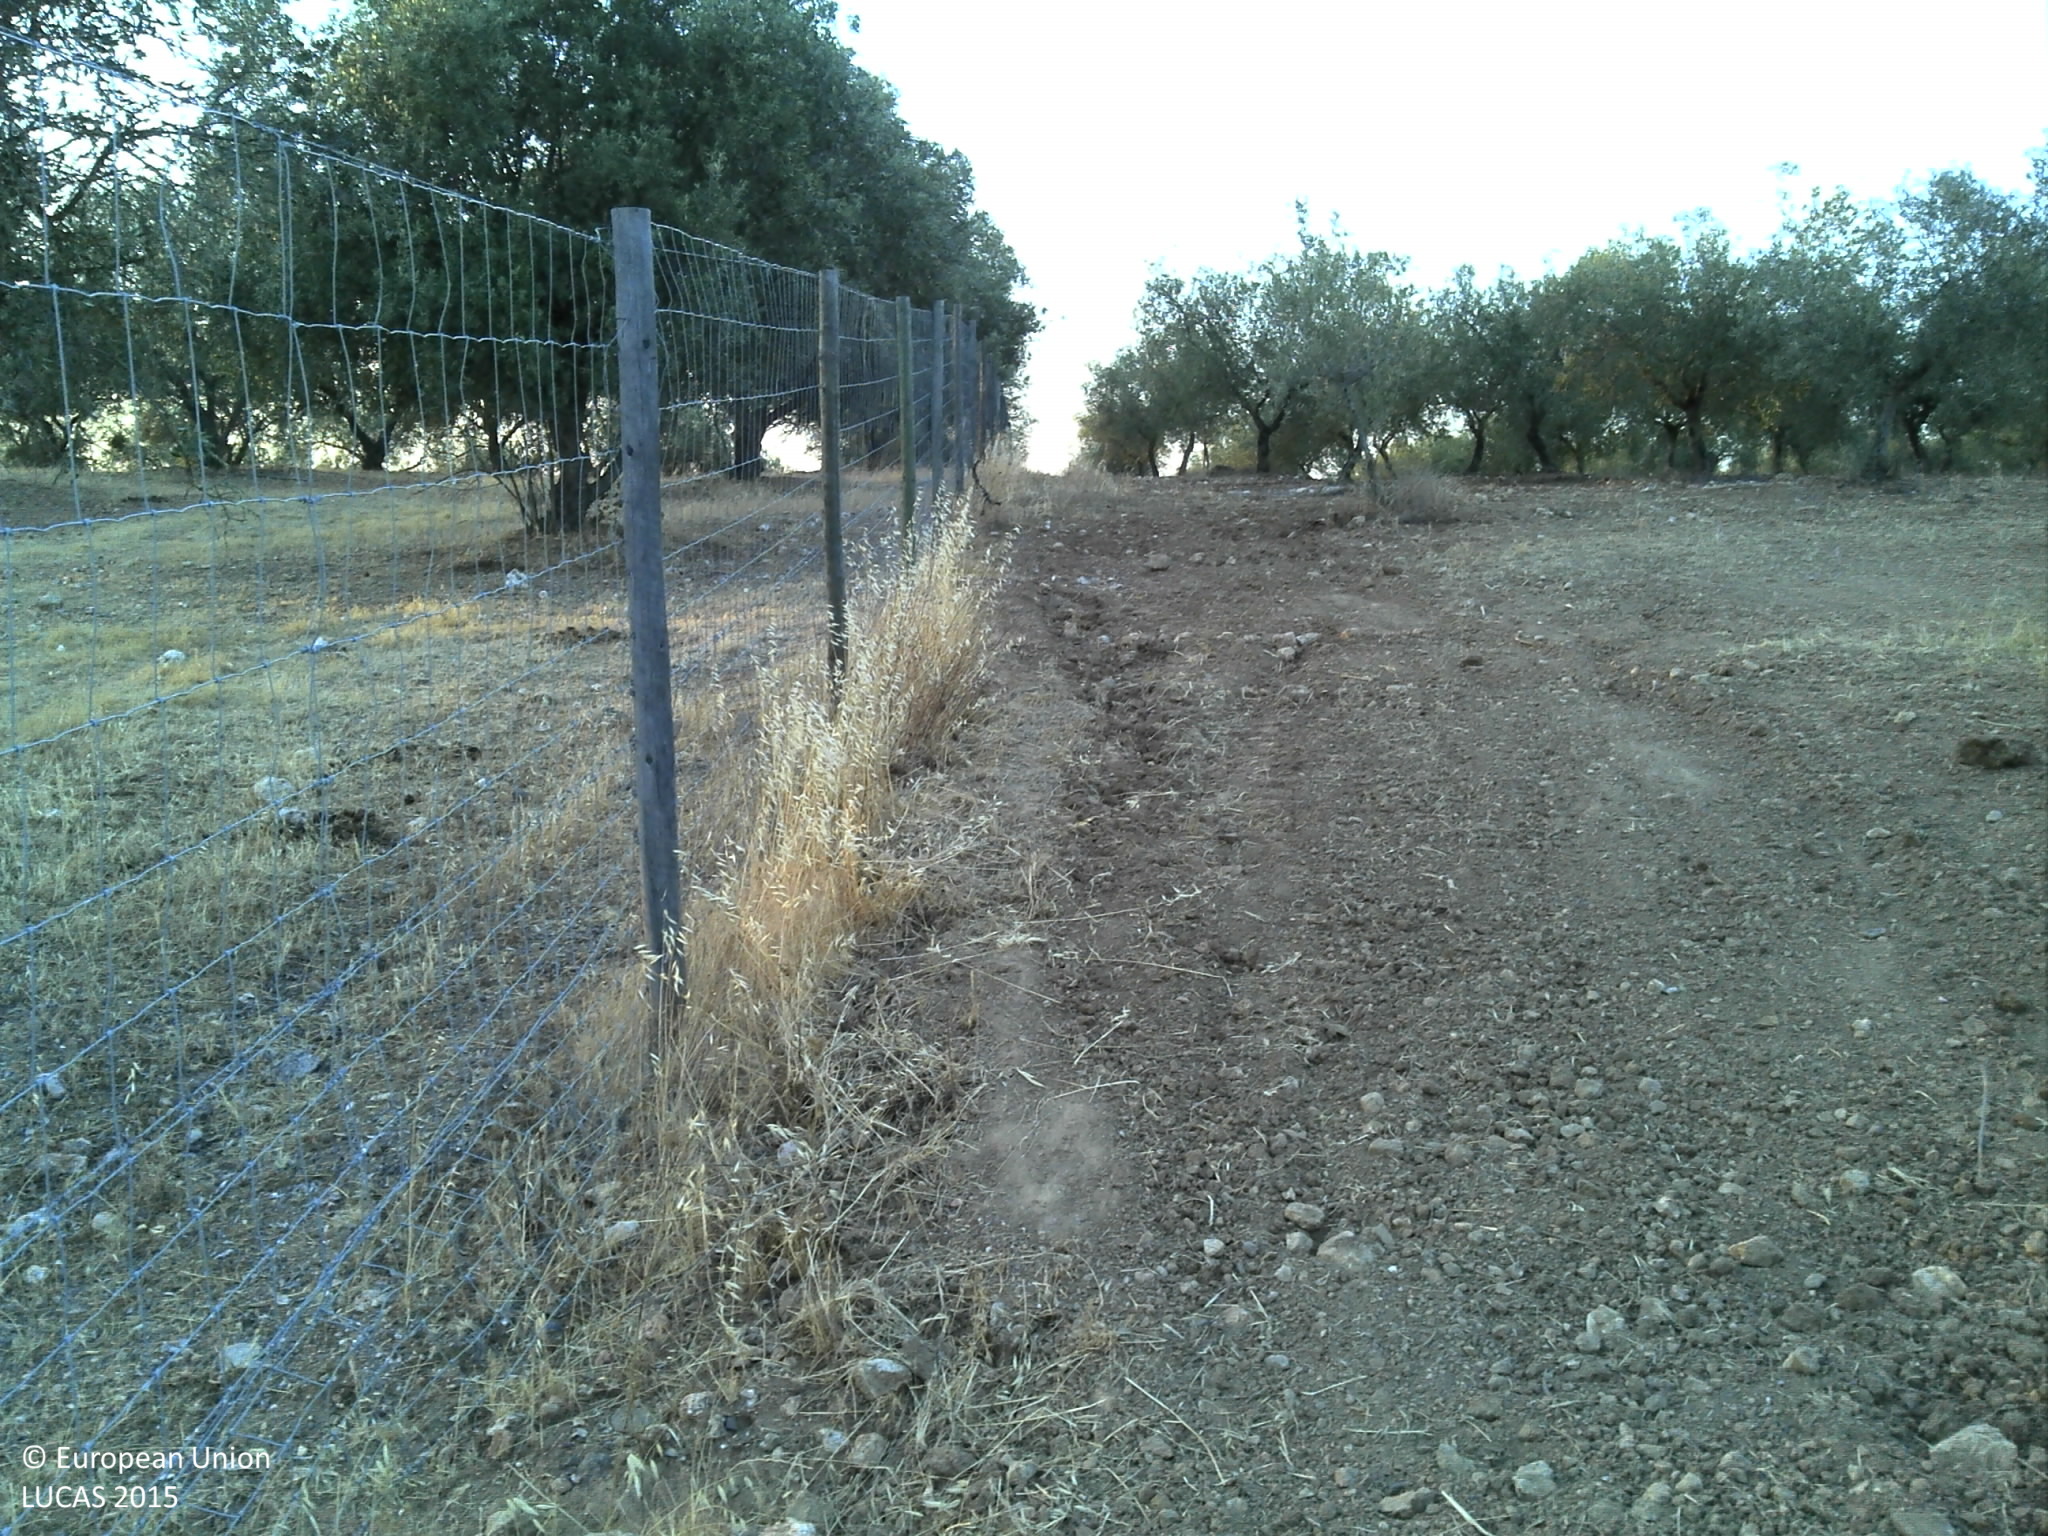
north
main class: Cropland
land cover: Olive groves
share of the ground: 50 - 75 %
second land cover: Grassland without tree/shrub cover
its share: 10 - 25 %
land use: Agriculture (excluding fallow land and kitchen gardens)
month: June
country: PT
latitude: 38.2023
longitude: -7.3895
